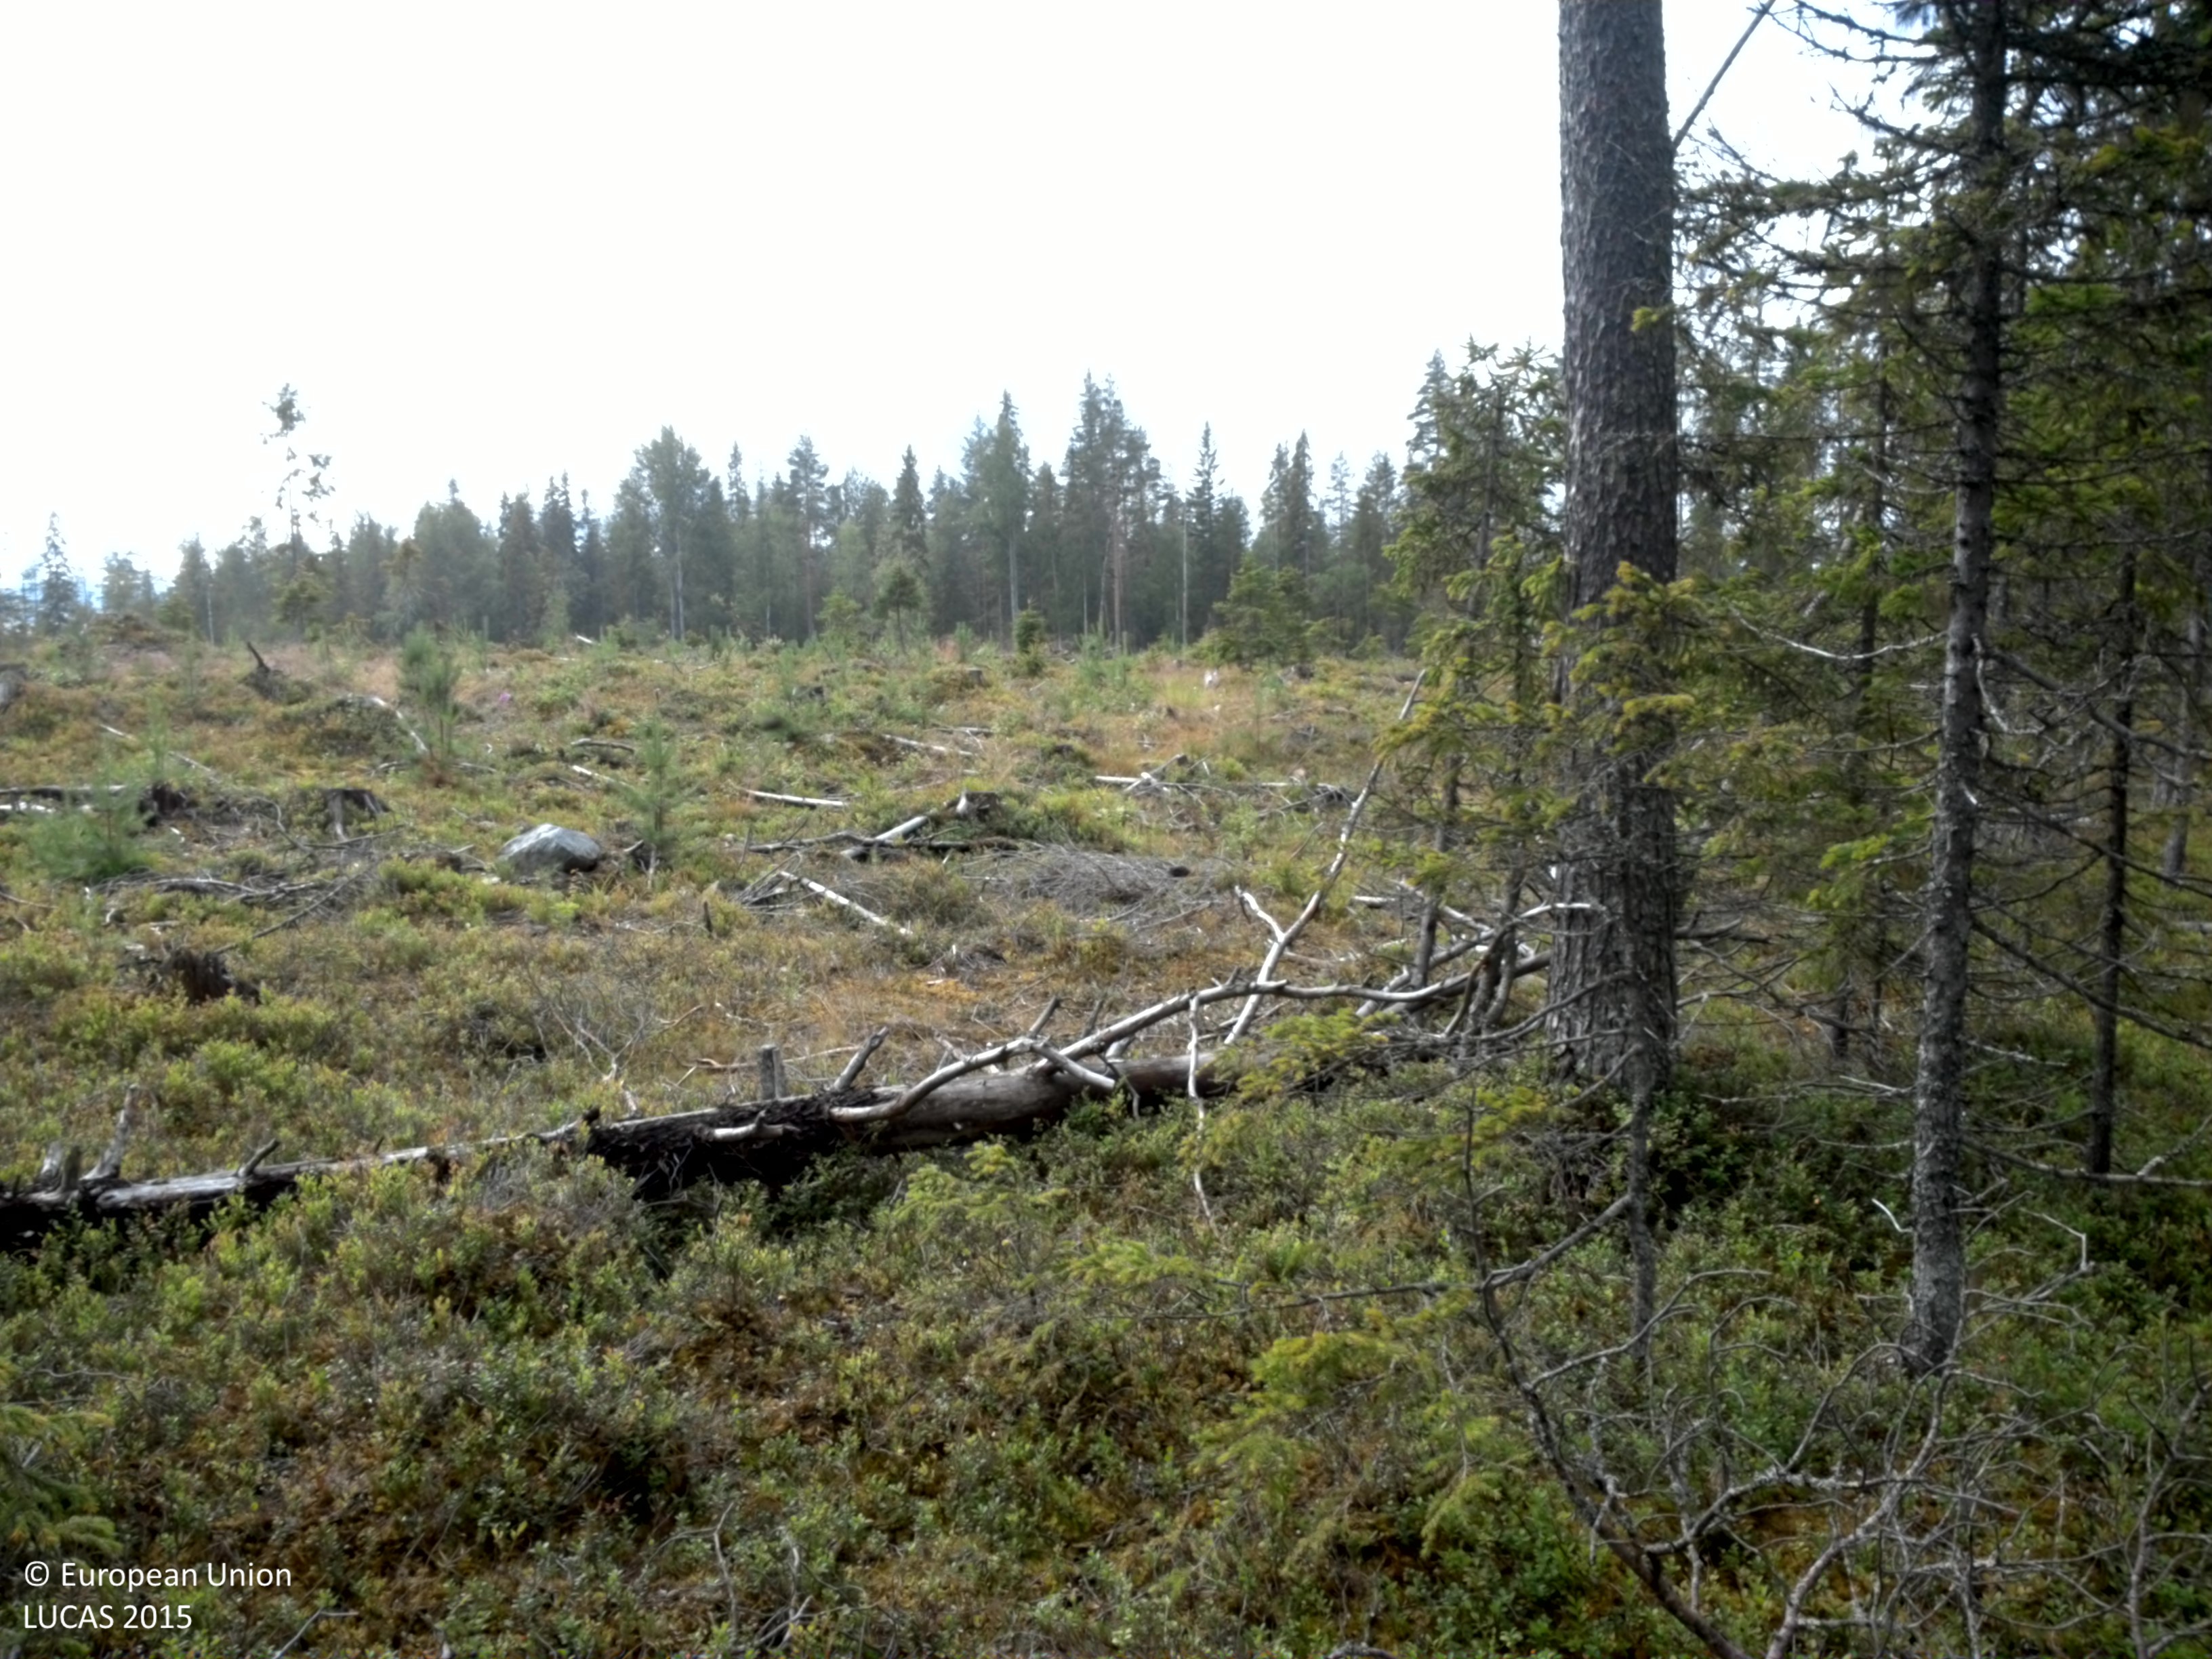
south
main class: Woodland
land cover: Pine dominated coniferous woodland
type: boreal forest
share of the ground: 50 - 75 %
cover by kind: coniferous forest trees 60 %, shrubs 35 %, lichens and mosses 5 %
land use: Forestry
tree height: > 5 m
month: August
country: SE
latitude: 64.7510
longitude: 20.3745
